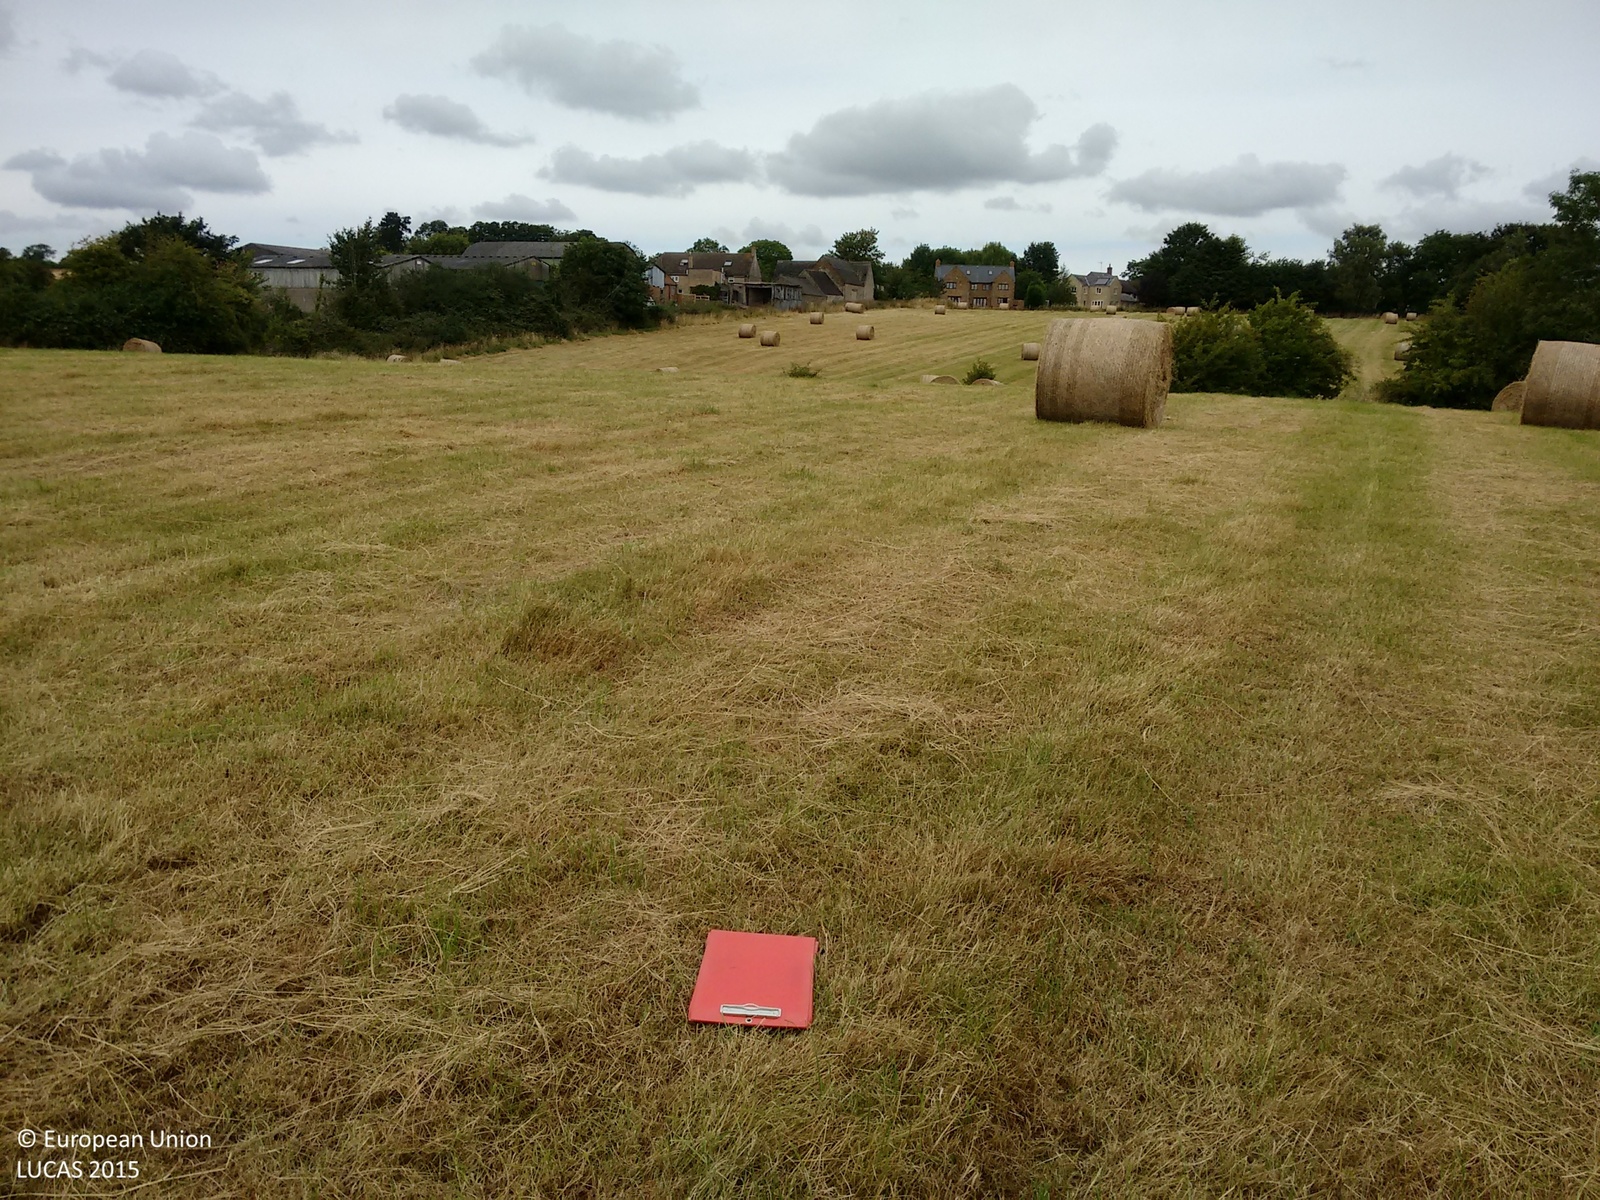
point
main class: Grassland
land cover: Grassland without tree/shrub cover
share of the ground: > 75 %
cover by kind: herbaceous plants 100 %
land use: Agriculture (excluding fallow land and kitchen gardens)
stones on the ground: < 10 %
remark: Harvested field
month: August
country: GB
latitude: 52.1011
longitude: -1.1857
